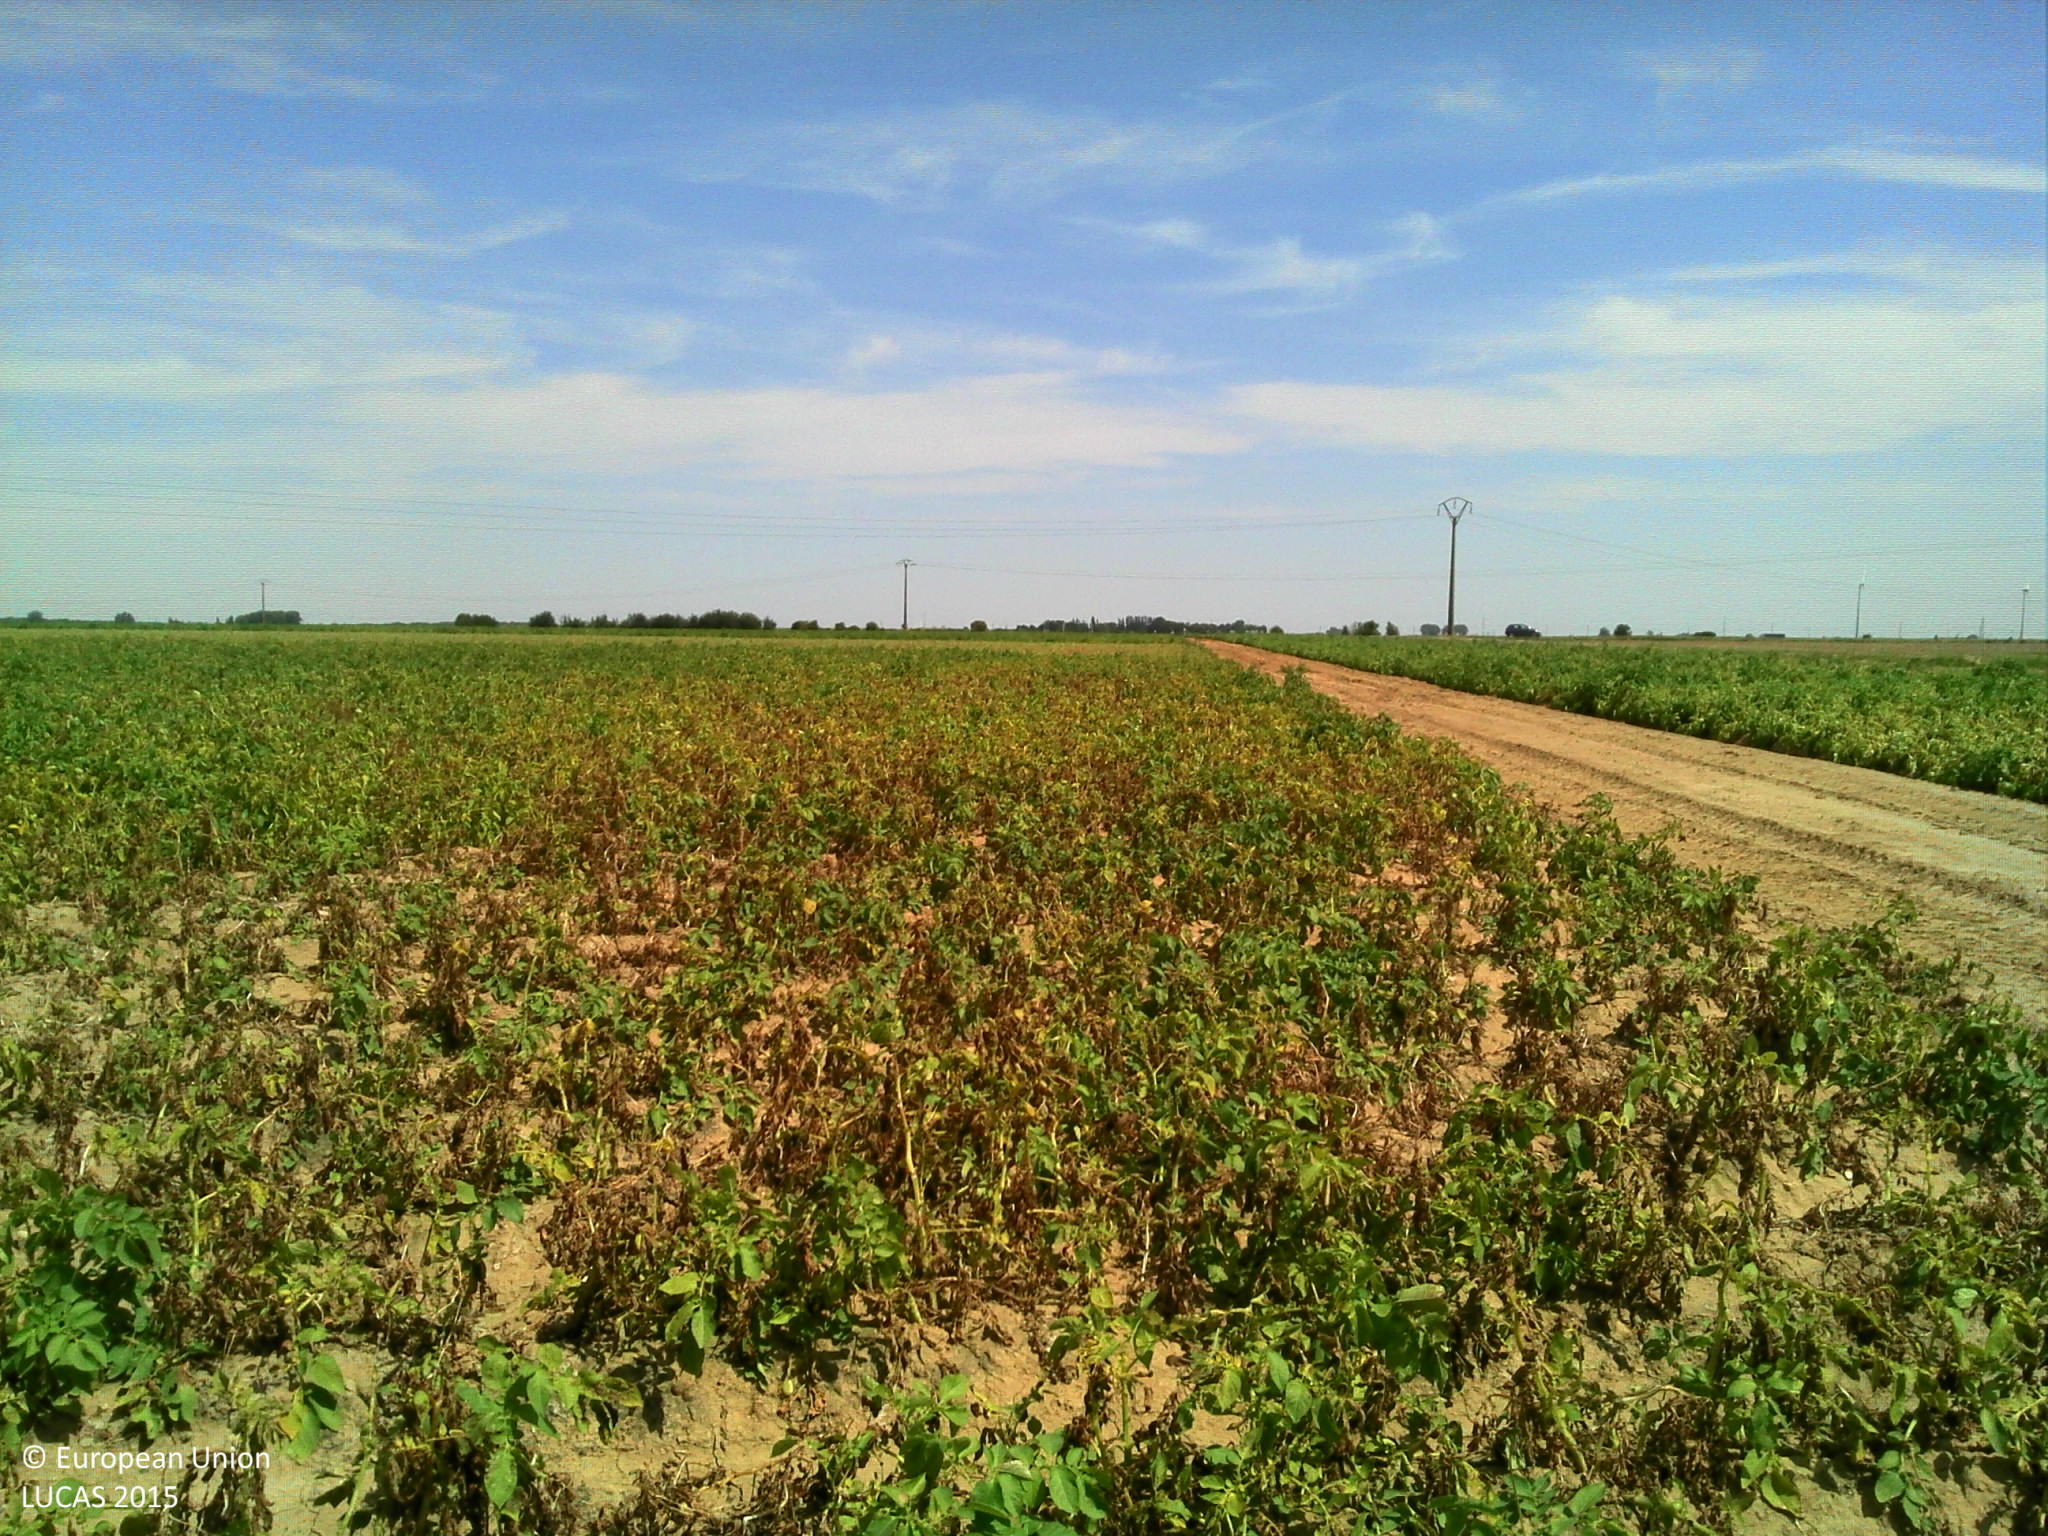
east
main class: Cropland
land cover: Potatoes
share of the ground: 25 - 50 %
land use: Agriculture (excluding fallow land and kitchen gardens)
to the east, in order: Potatoes; Electric lines; Grass margins; Paved roads, cycling and walking lanes
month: August
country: FR
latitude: 49.7390
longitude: 2.7877
